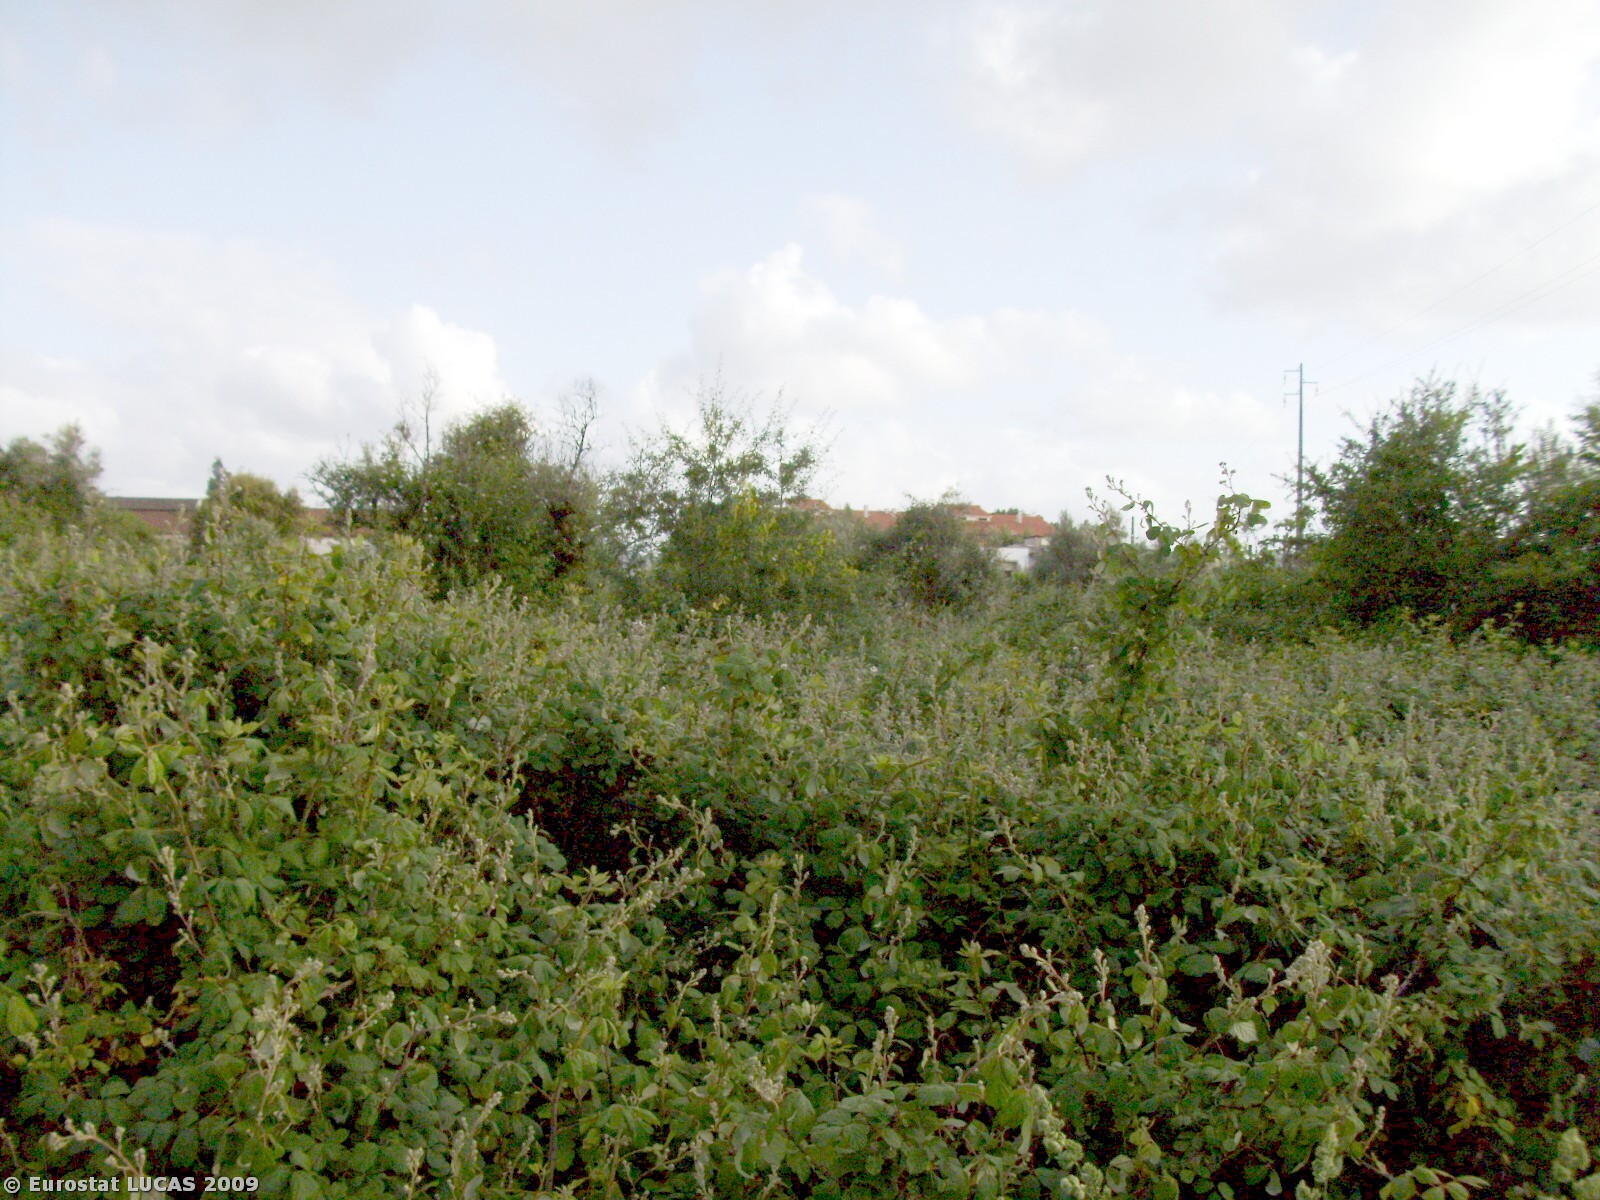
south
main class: Shrubland
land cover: Shrubland with sparse tree cover
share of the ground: > 75 %
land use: Fallow land
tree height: < 5 m
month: June
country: PT
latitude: 39.9227
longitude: -8.3639
